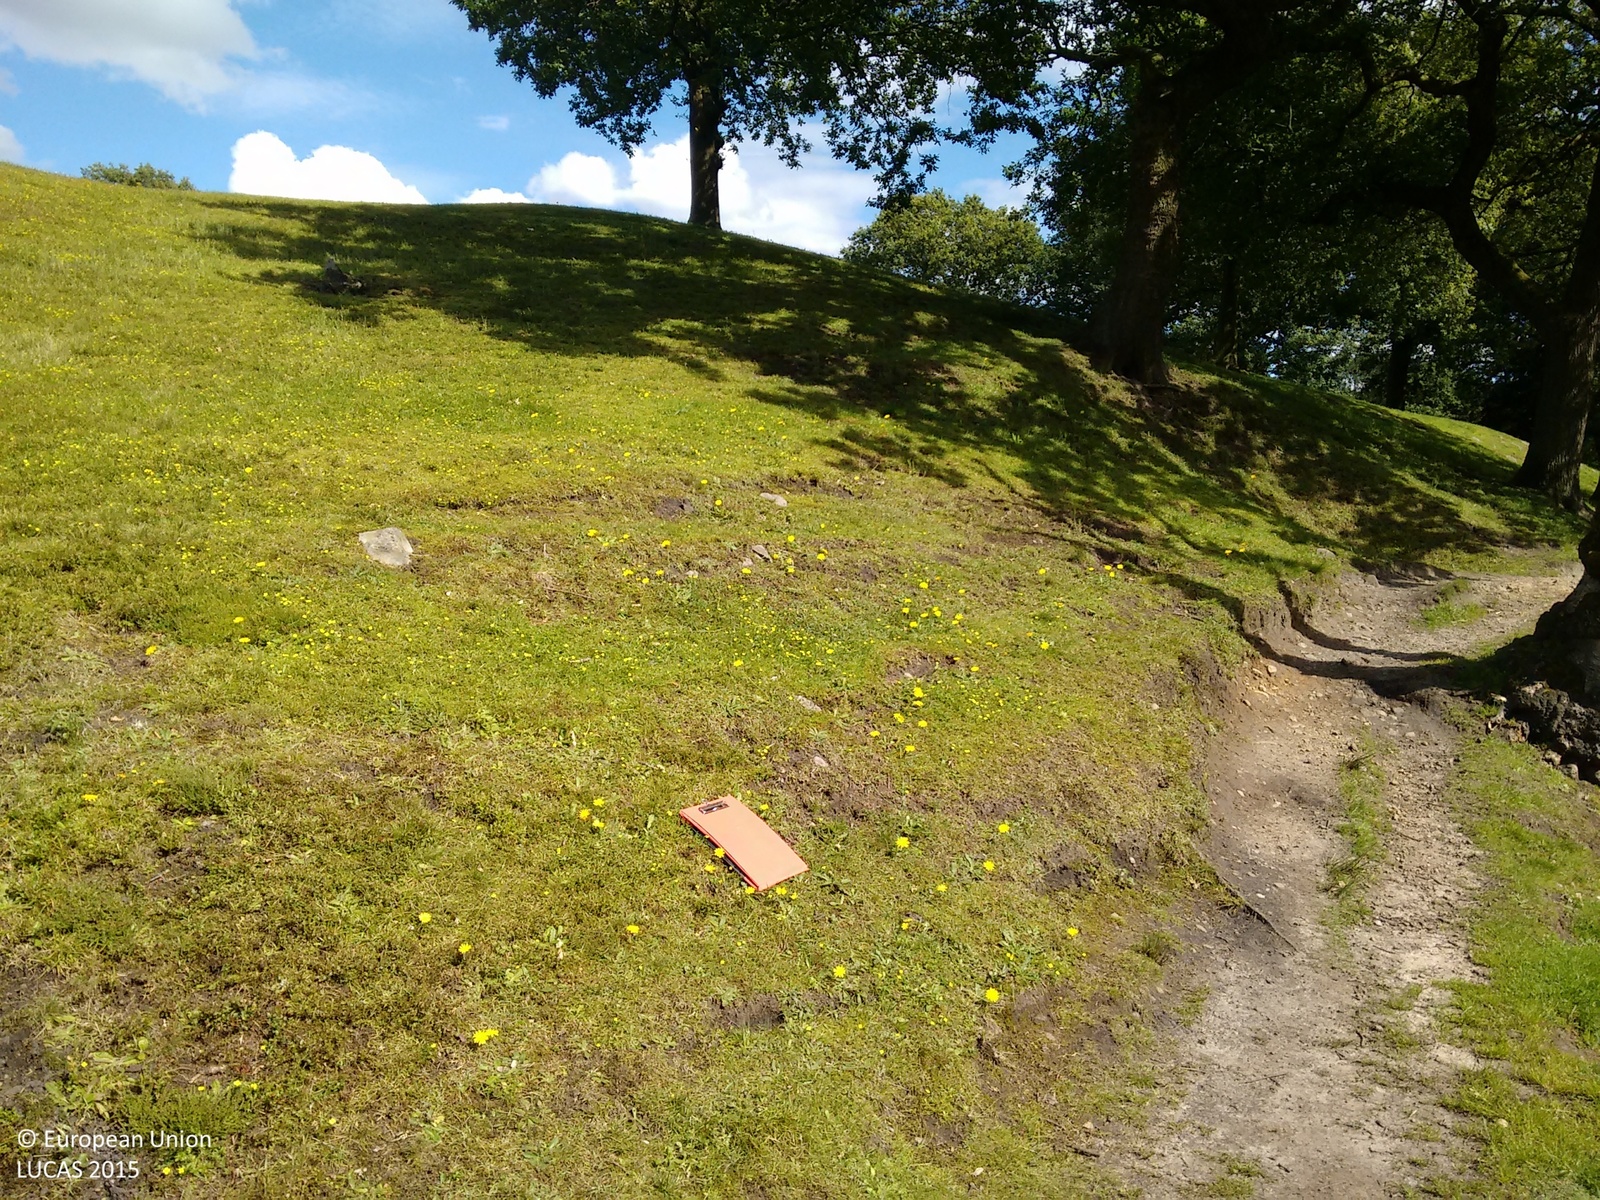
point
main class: Woodland
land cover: Broadleaved woodland
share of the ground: > 75 %
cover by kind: herbaceous plants 80 %, broadleaved forest trees 15 %, unconsolidated bare surface 5 %
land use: Amenities, museums, leisure
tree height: > 5 m
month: August
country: GB
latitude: 55.9974
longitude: -3.8572
